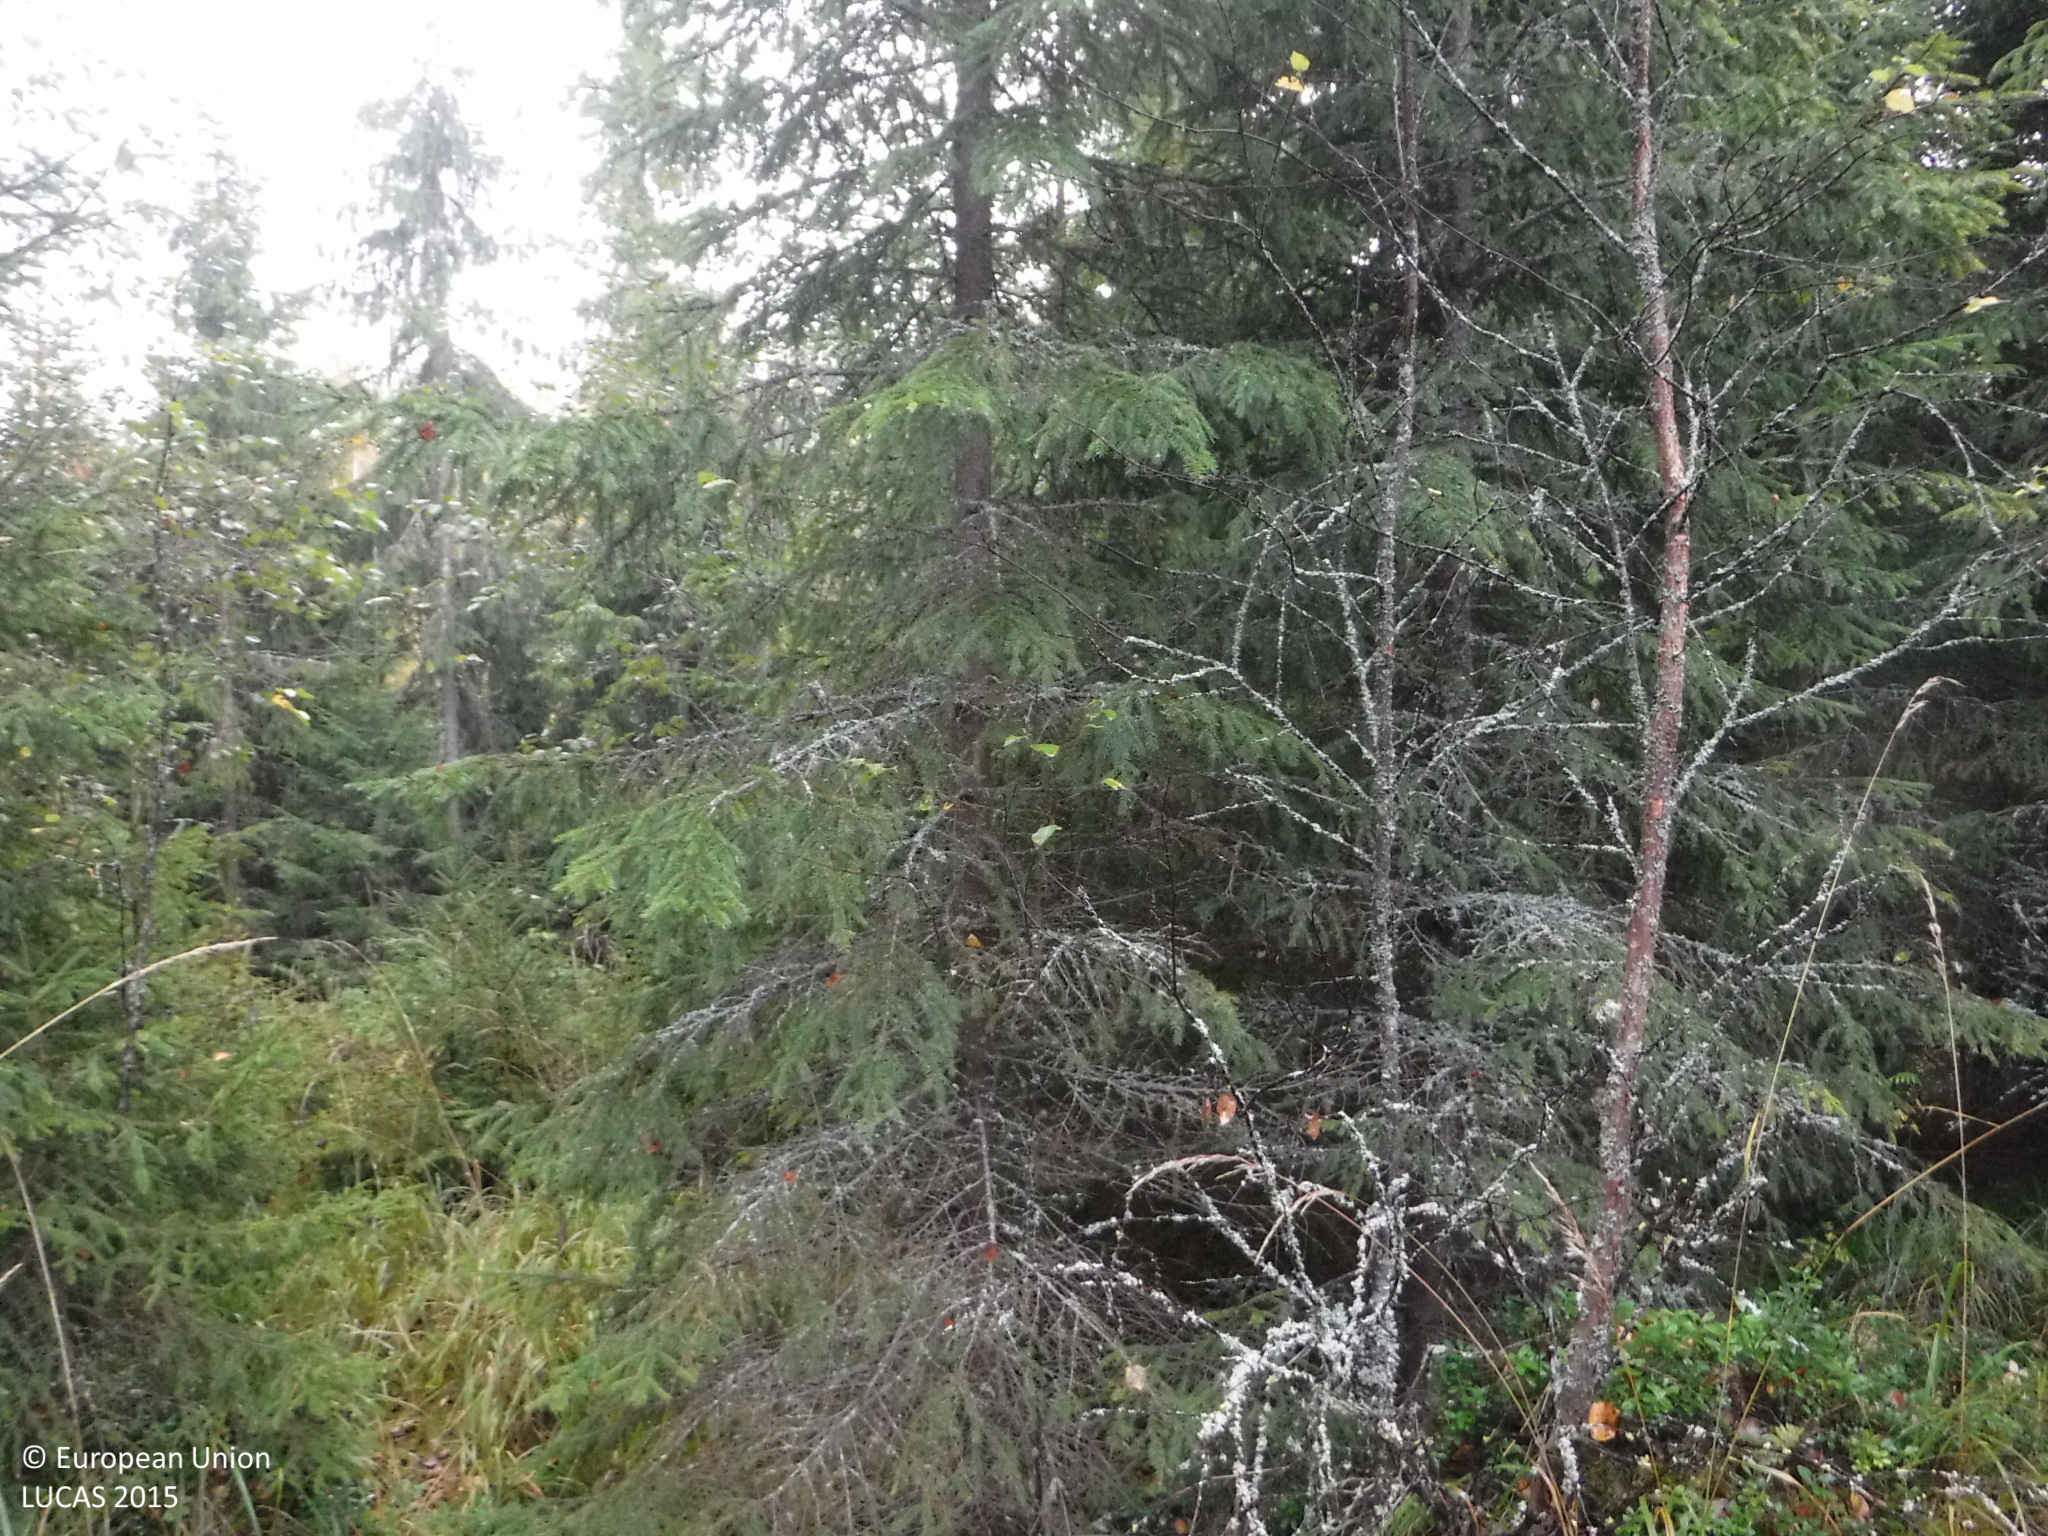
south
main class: Woodland
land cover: Spruce dominated coniferous woodland
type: boreal forest
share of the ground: 50 - 75 %
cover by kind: coniferous forest trees 55 %, herbaceous plants 40 %, lichens and mosses 5 %
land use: Forestry
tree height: > 5 m
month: September
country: FI
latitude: 61.7053
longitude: 24.1022
